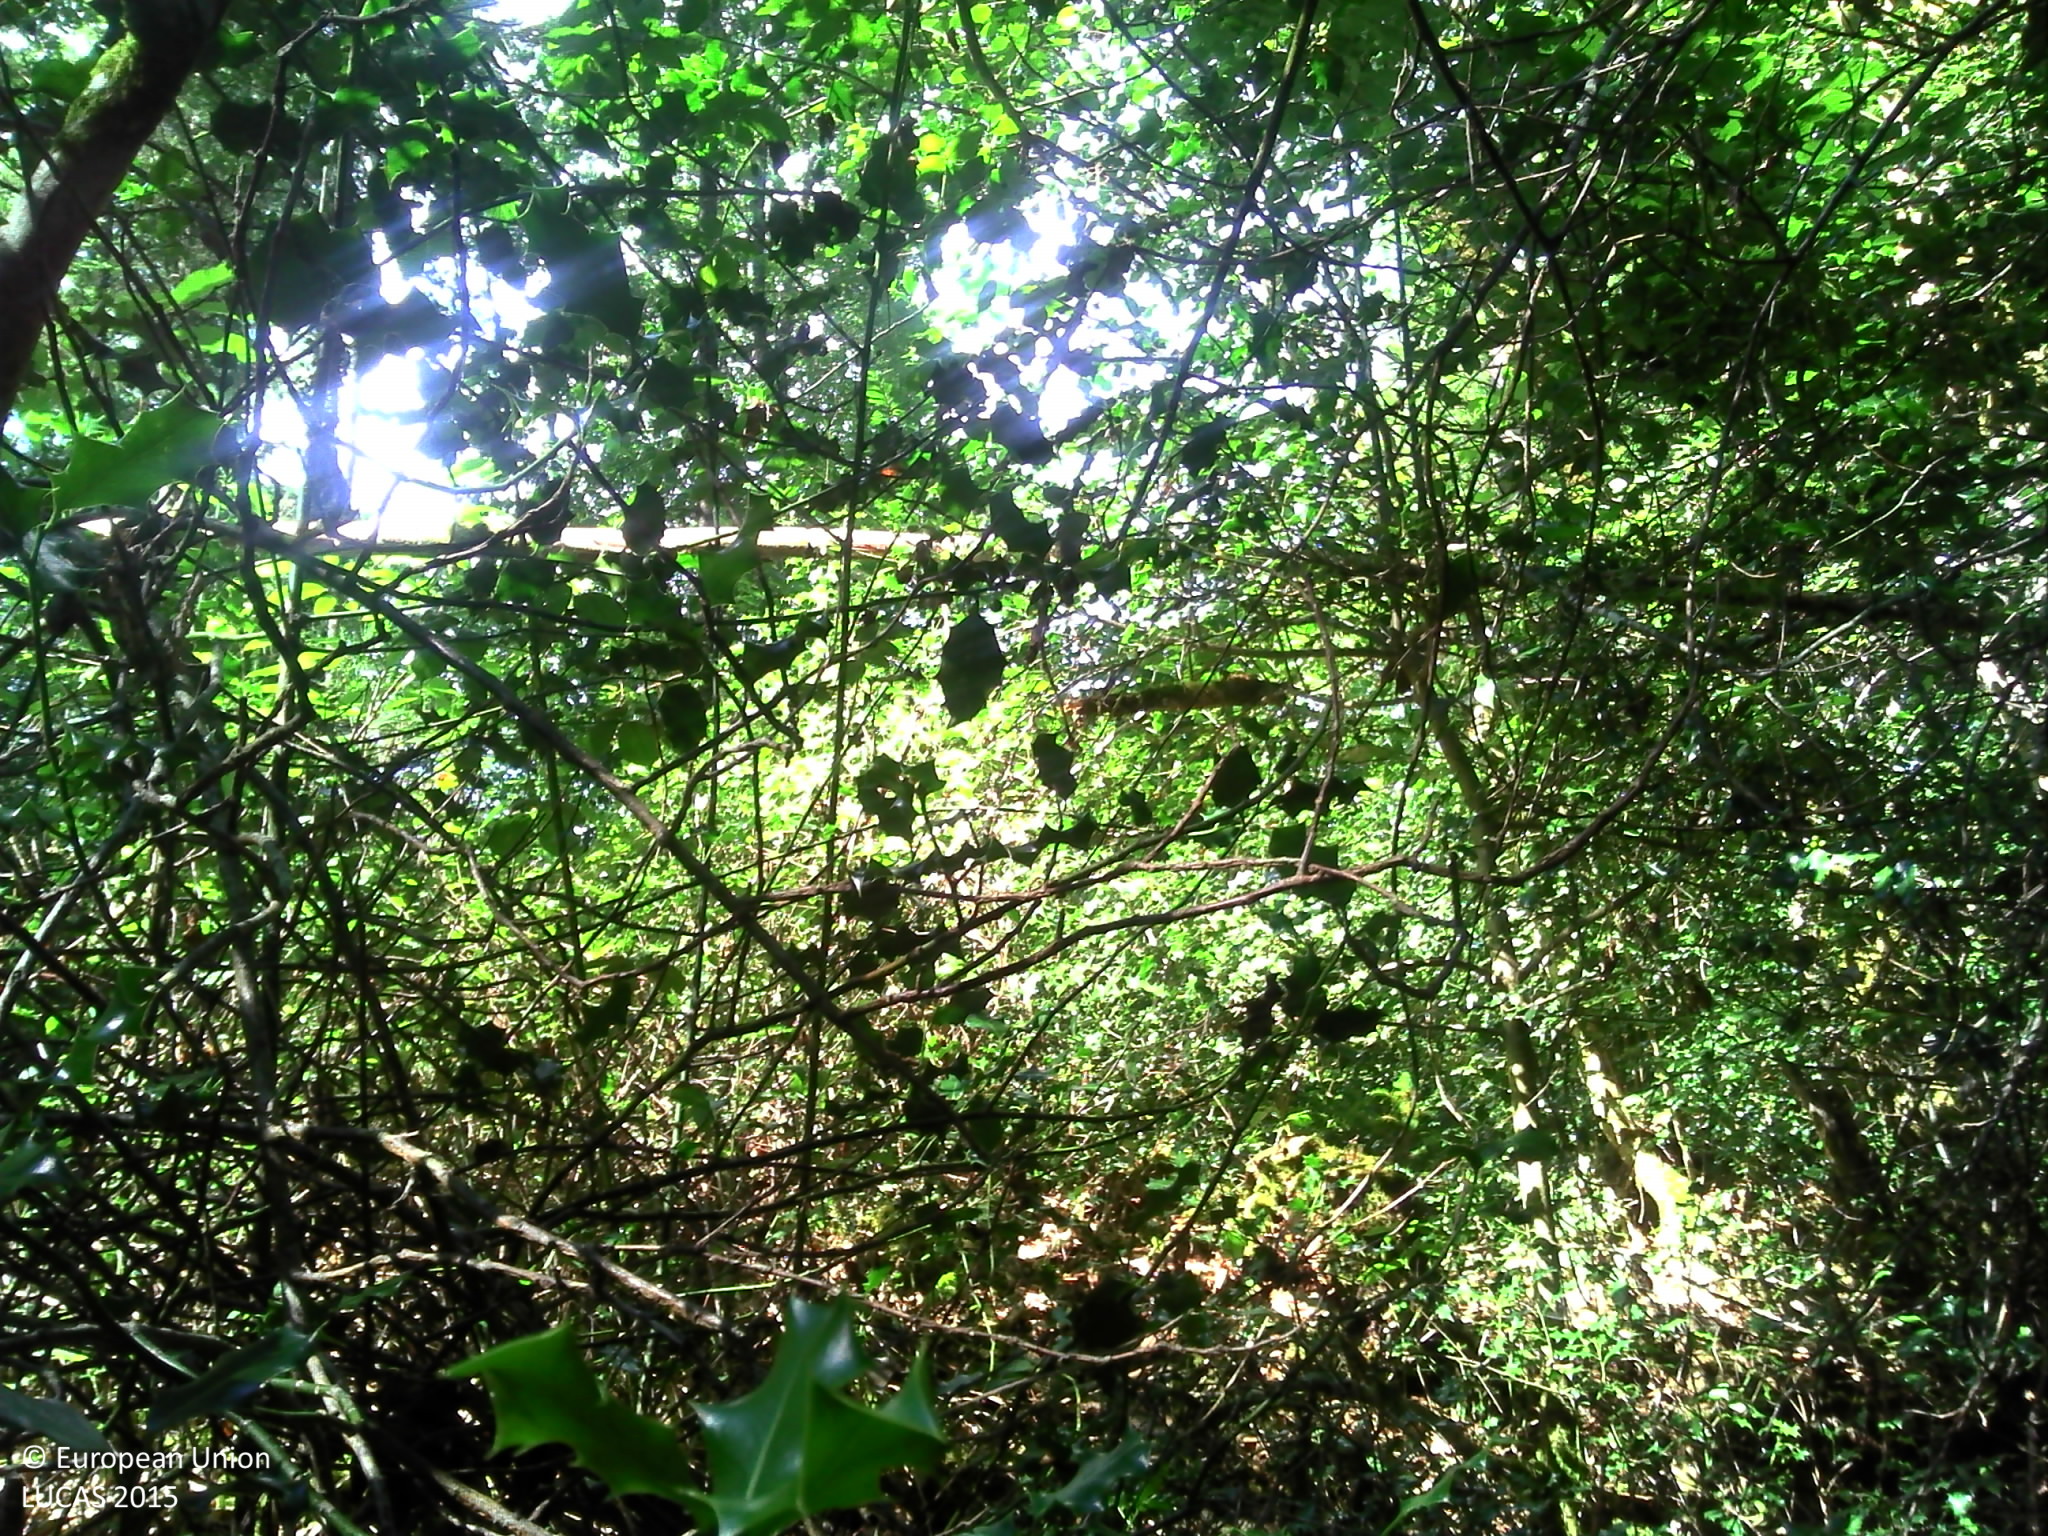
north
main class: Woodland
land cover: Spruce dominated mixed woodland
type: mesophytic deciduous forest
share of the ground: > 75 %
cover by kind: broadleaved forest trees 40 %, coniferous forest trees 25 %, shrubs 25 %, herbaceous plants 5 %, lichens and mosses 5 %
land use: Forestry
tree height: > 5 m
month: August
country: FR
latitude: 45.9734
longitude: 1.6941
